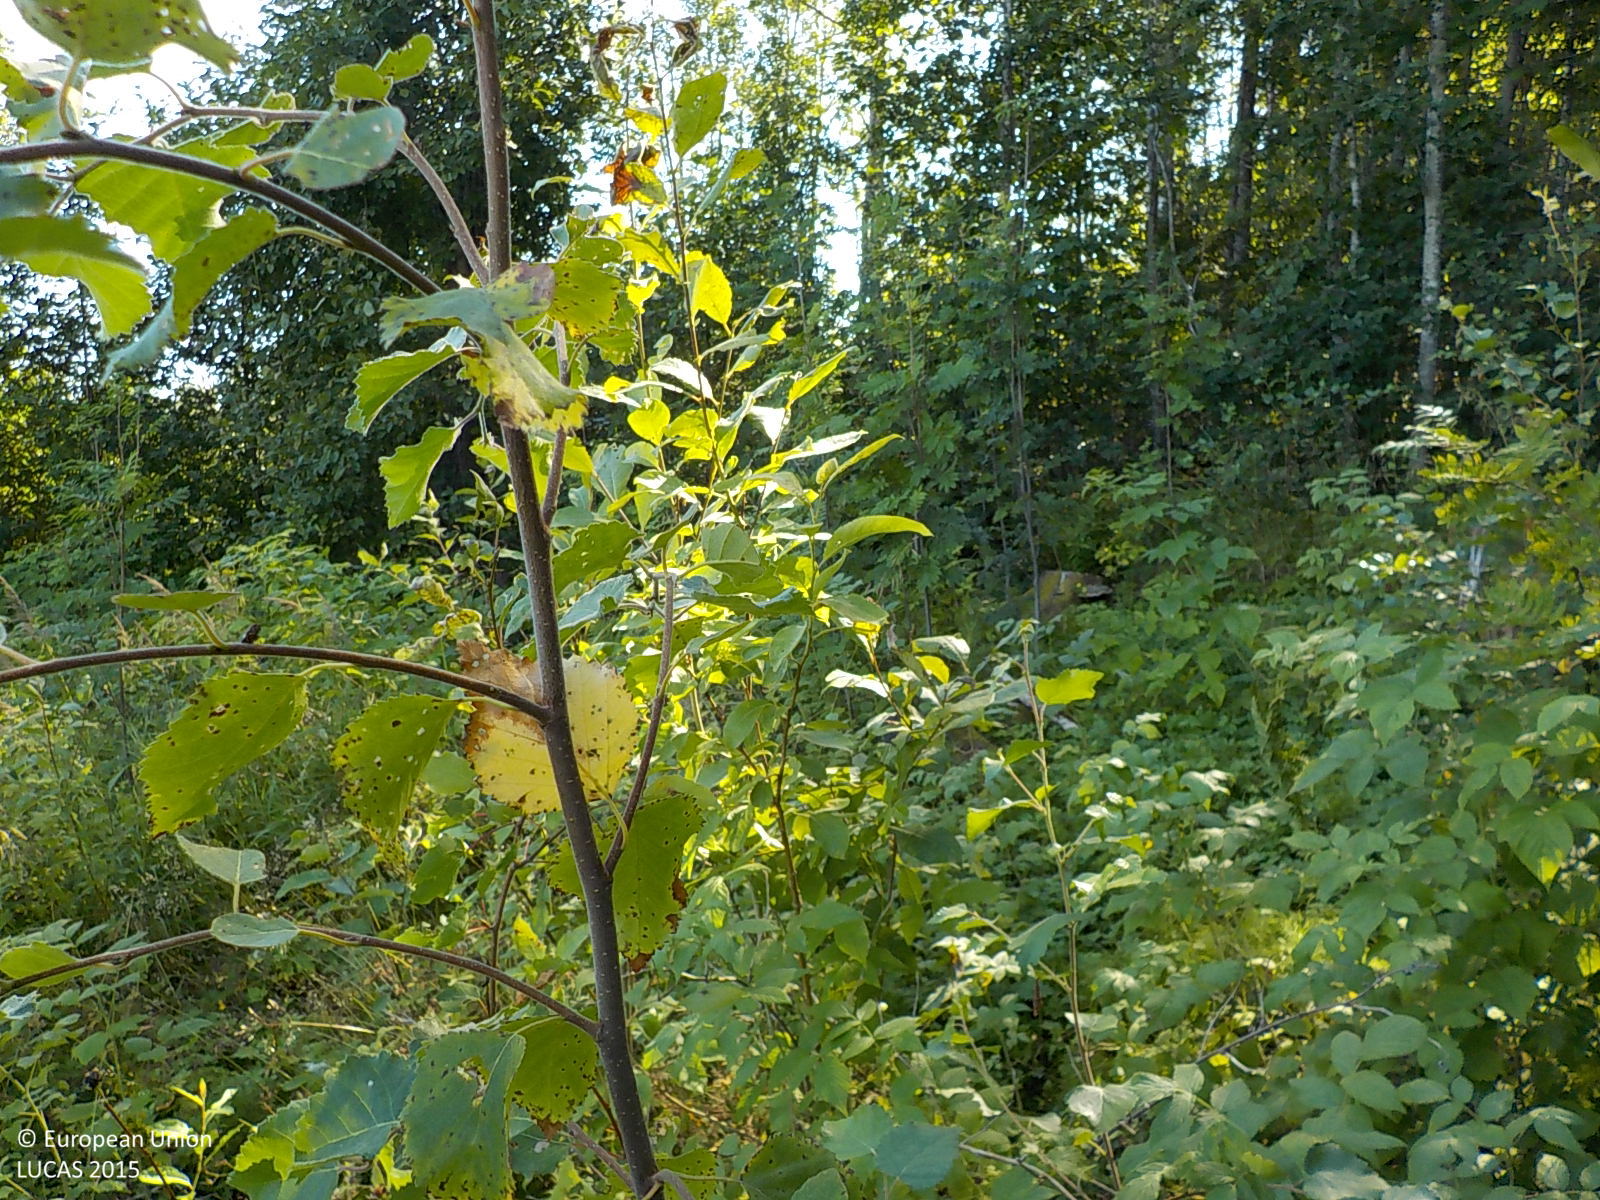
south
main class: Woodland
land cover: Broadleaved woodland
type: hemiboreal forest and nemoral coniferous forest and mixed broadleaved-coniferous forest
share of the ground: > 75 %
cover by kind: broadleaved forest trees 85 %, herbaceous plants 15 %
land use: Forestry
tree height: < 5 m
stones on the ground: 10 - 25 %
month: August
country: SE
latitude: 63.3318
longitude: 18.8654
